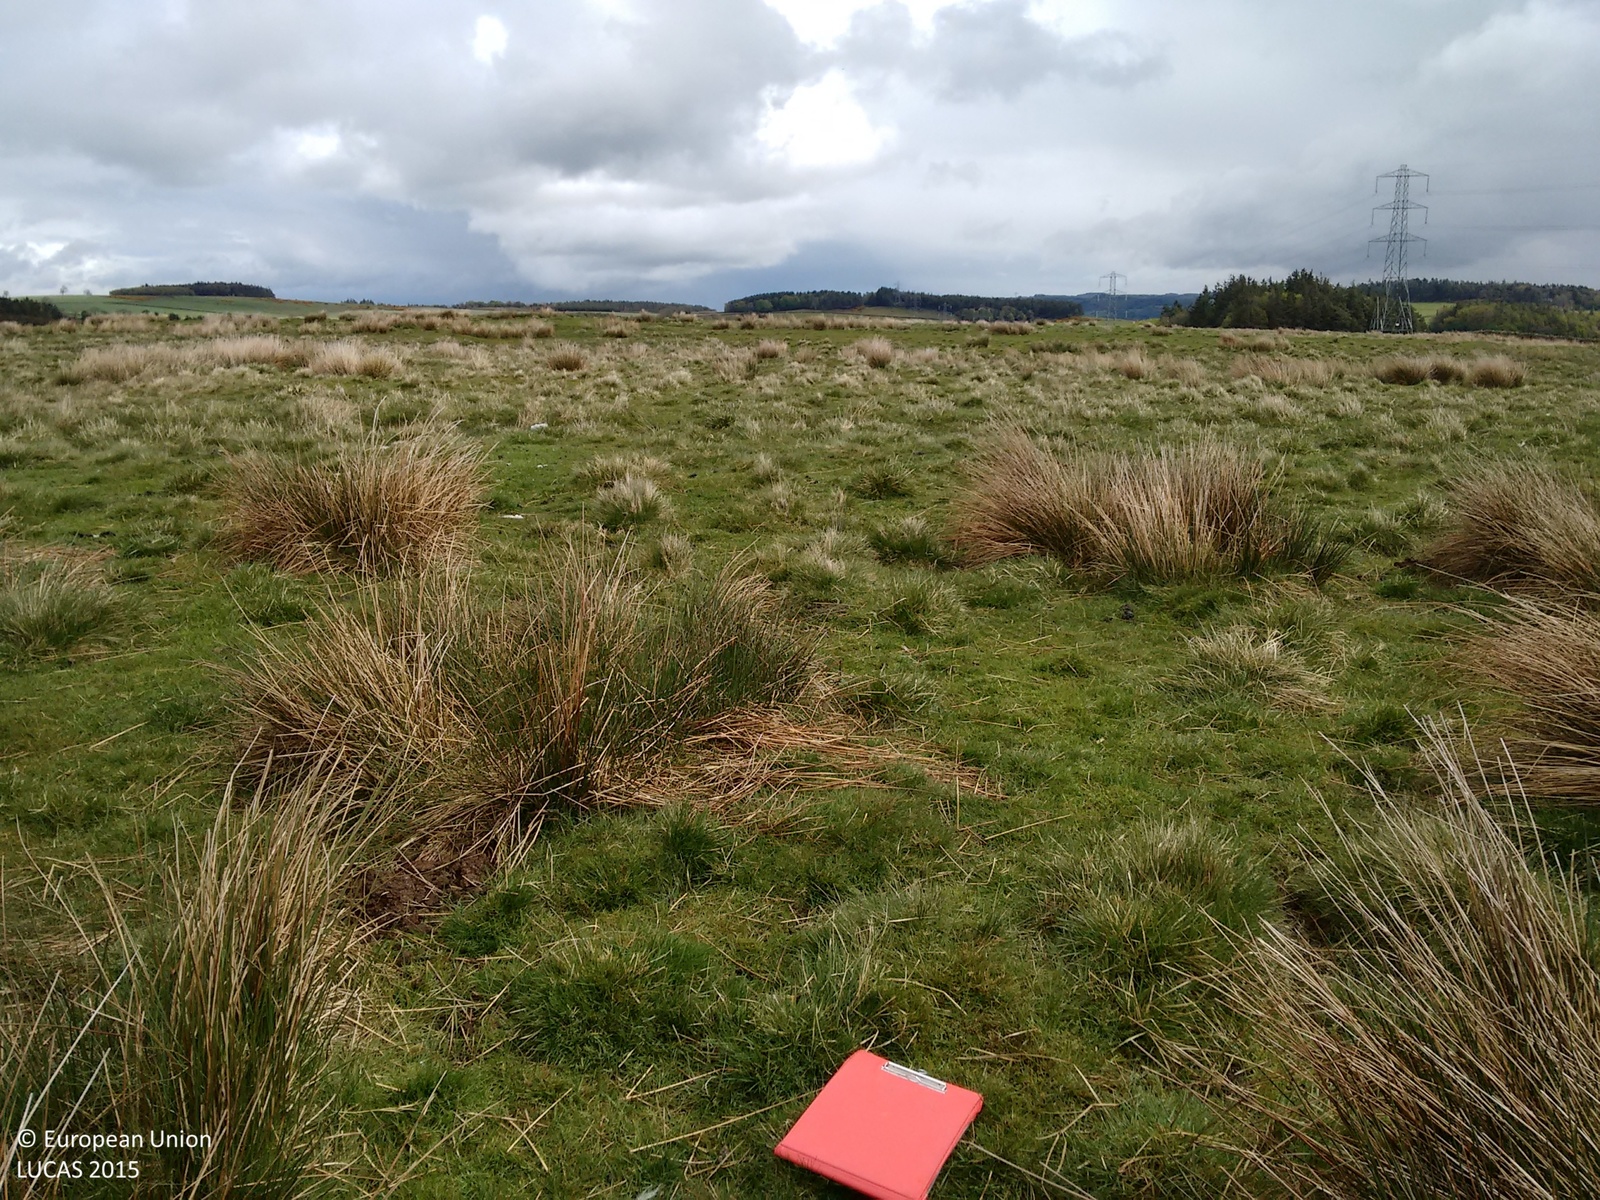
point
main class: Grassland
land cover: Grassland without tree/shrub cover
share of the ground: > 75 %
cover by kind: herbaceous plants 100 %
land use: Agriculture (excluding fallow land and kitchen gardens)
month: May
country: GB
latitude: 55.0194
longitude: -2.2105
